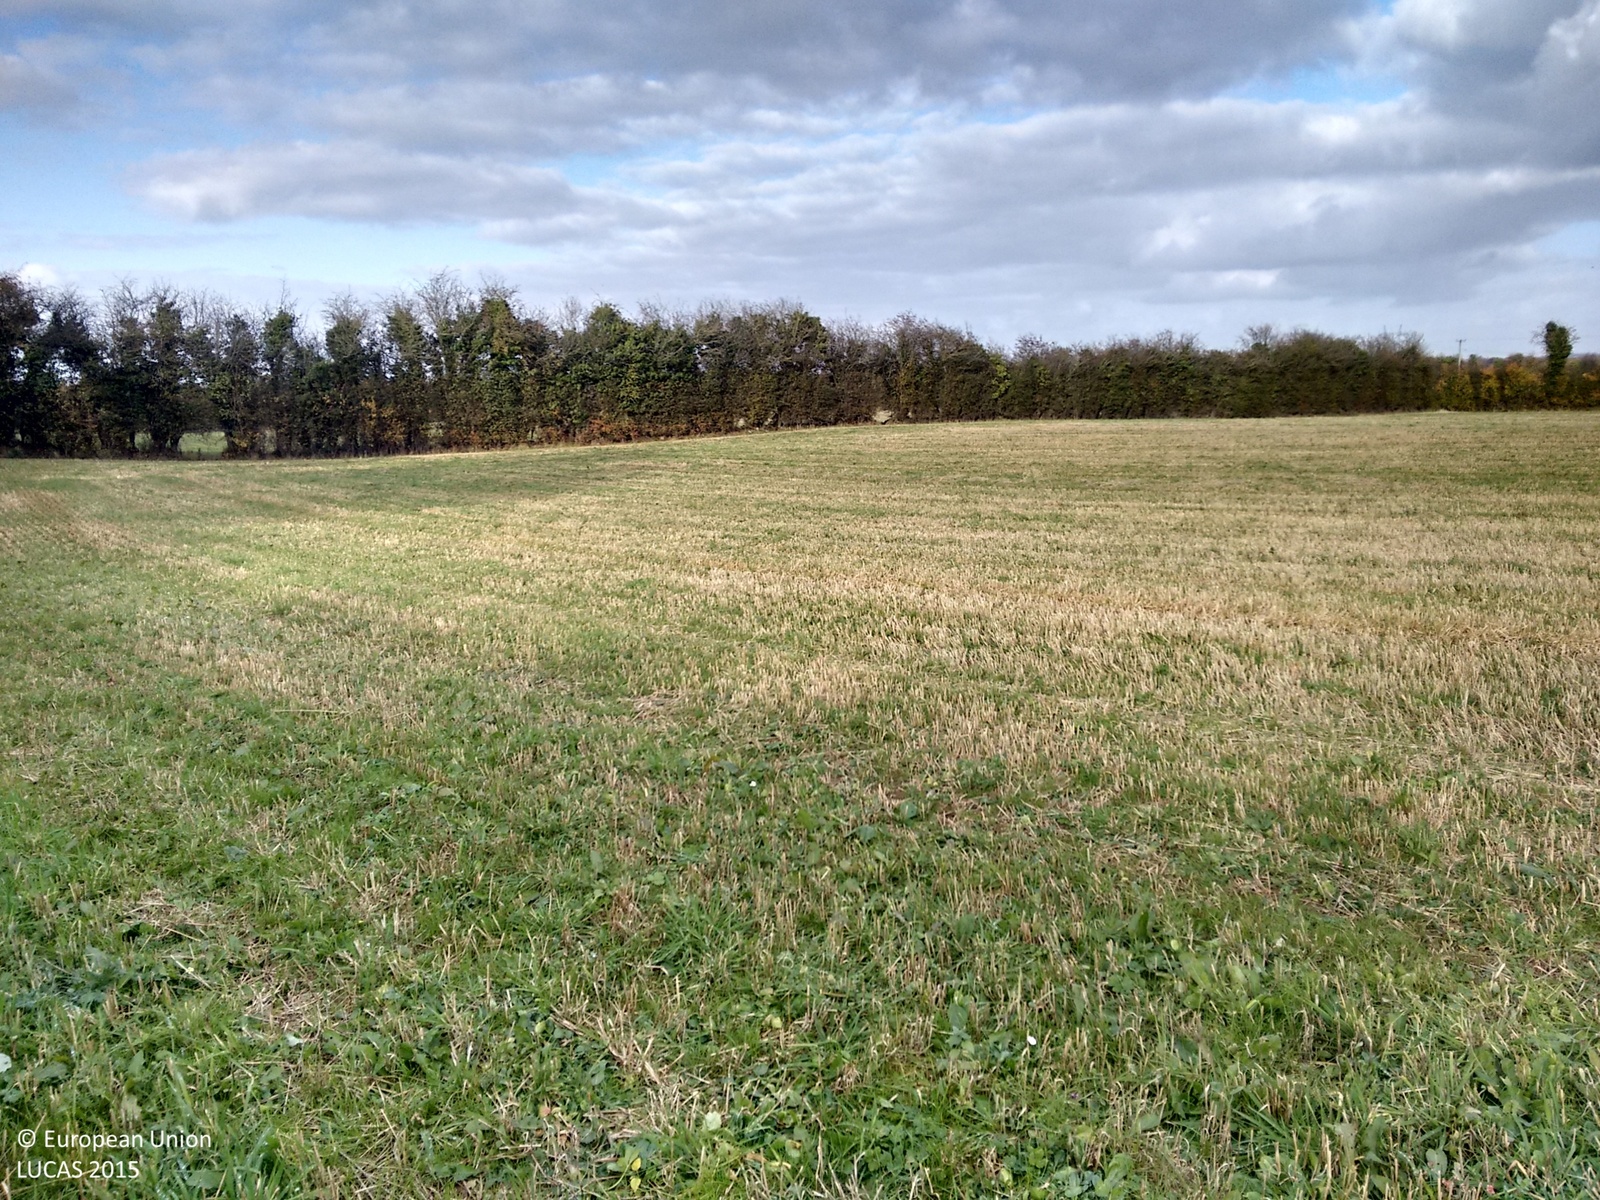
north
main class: Grassland
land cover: Grassland without tree/shrub cover
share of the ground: > 75 %
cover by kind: herbaceous plants 85 %, shrubs 5 %
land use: Agriculture (excluding fallow land and kitchen gardens)
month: October
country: IE
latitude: 53.1467
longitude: -7.7342
